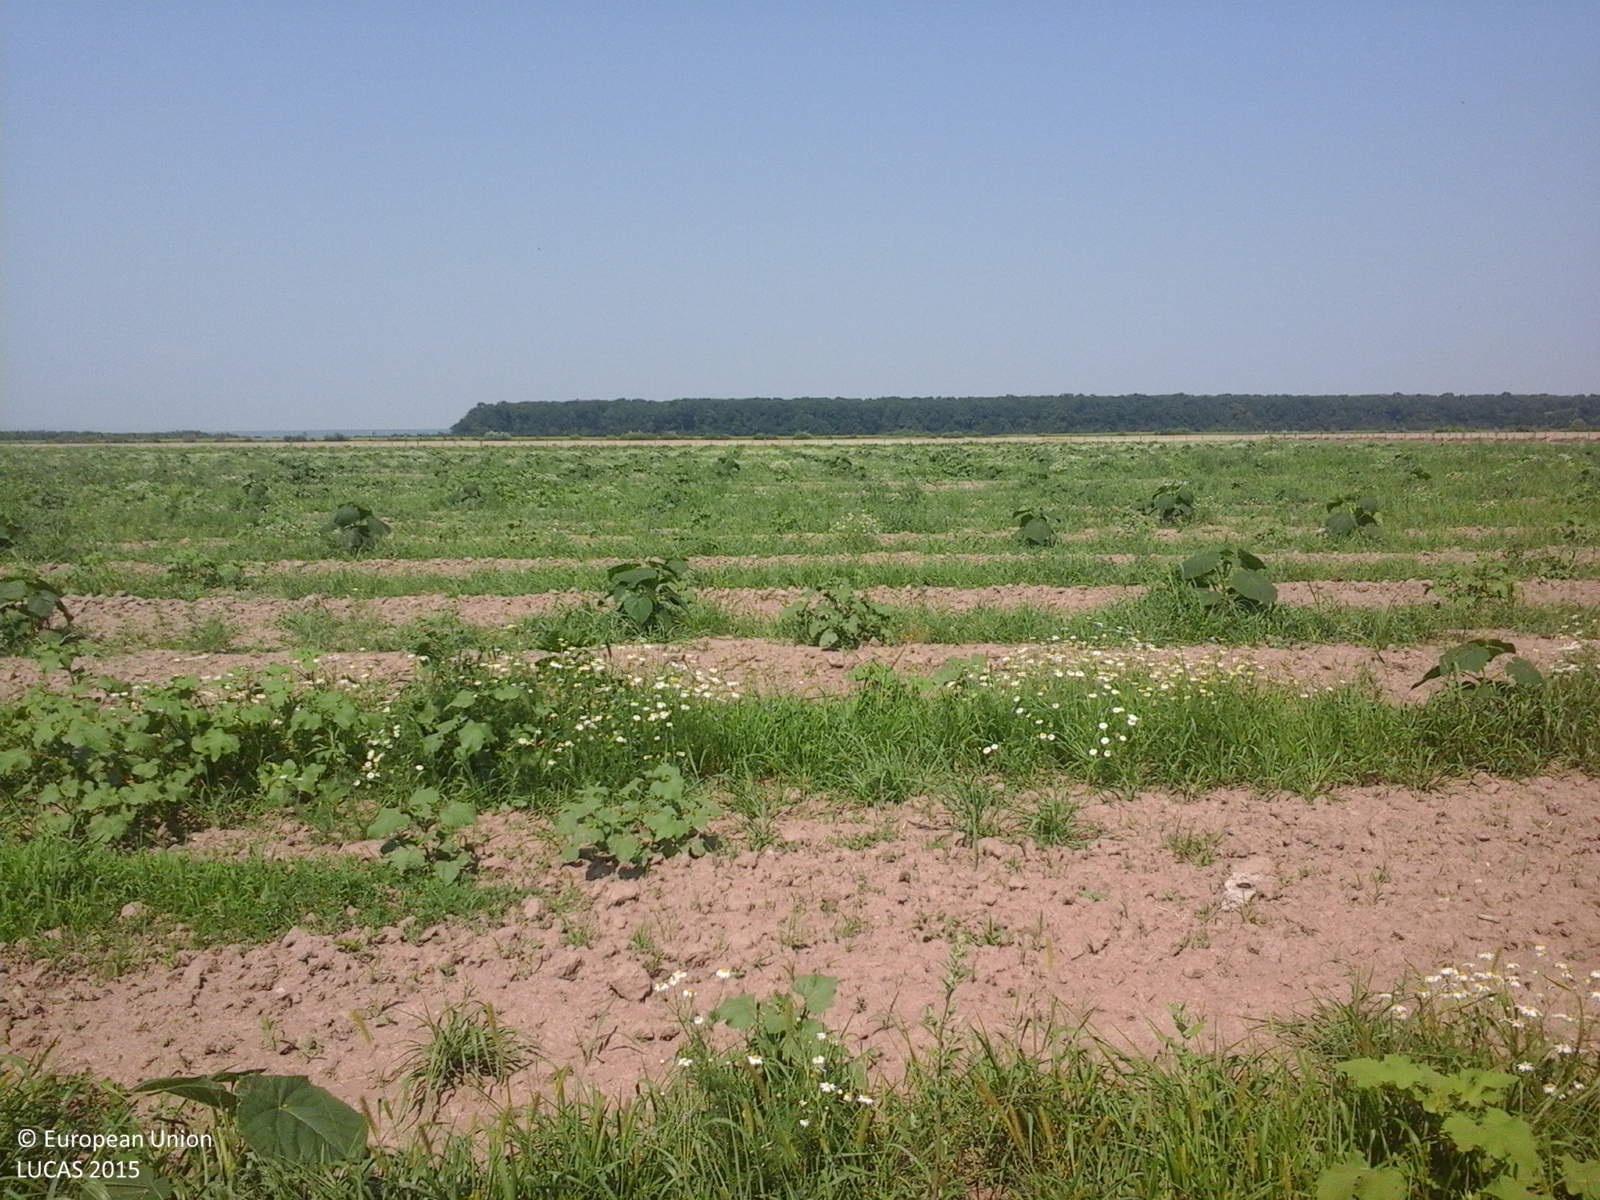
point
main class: Cropland
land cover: Nurseries
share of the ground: 10 - 25 %
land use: Forestry
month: July
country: RO
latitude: 44.8360
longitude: 25.5672
